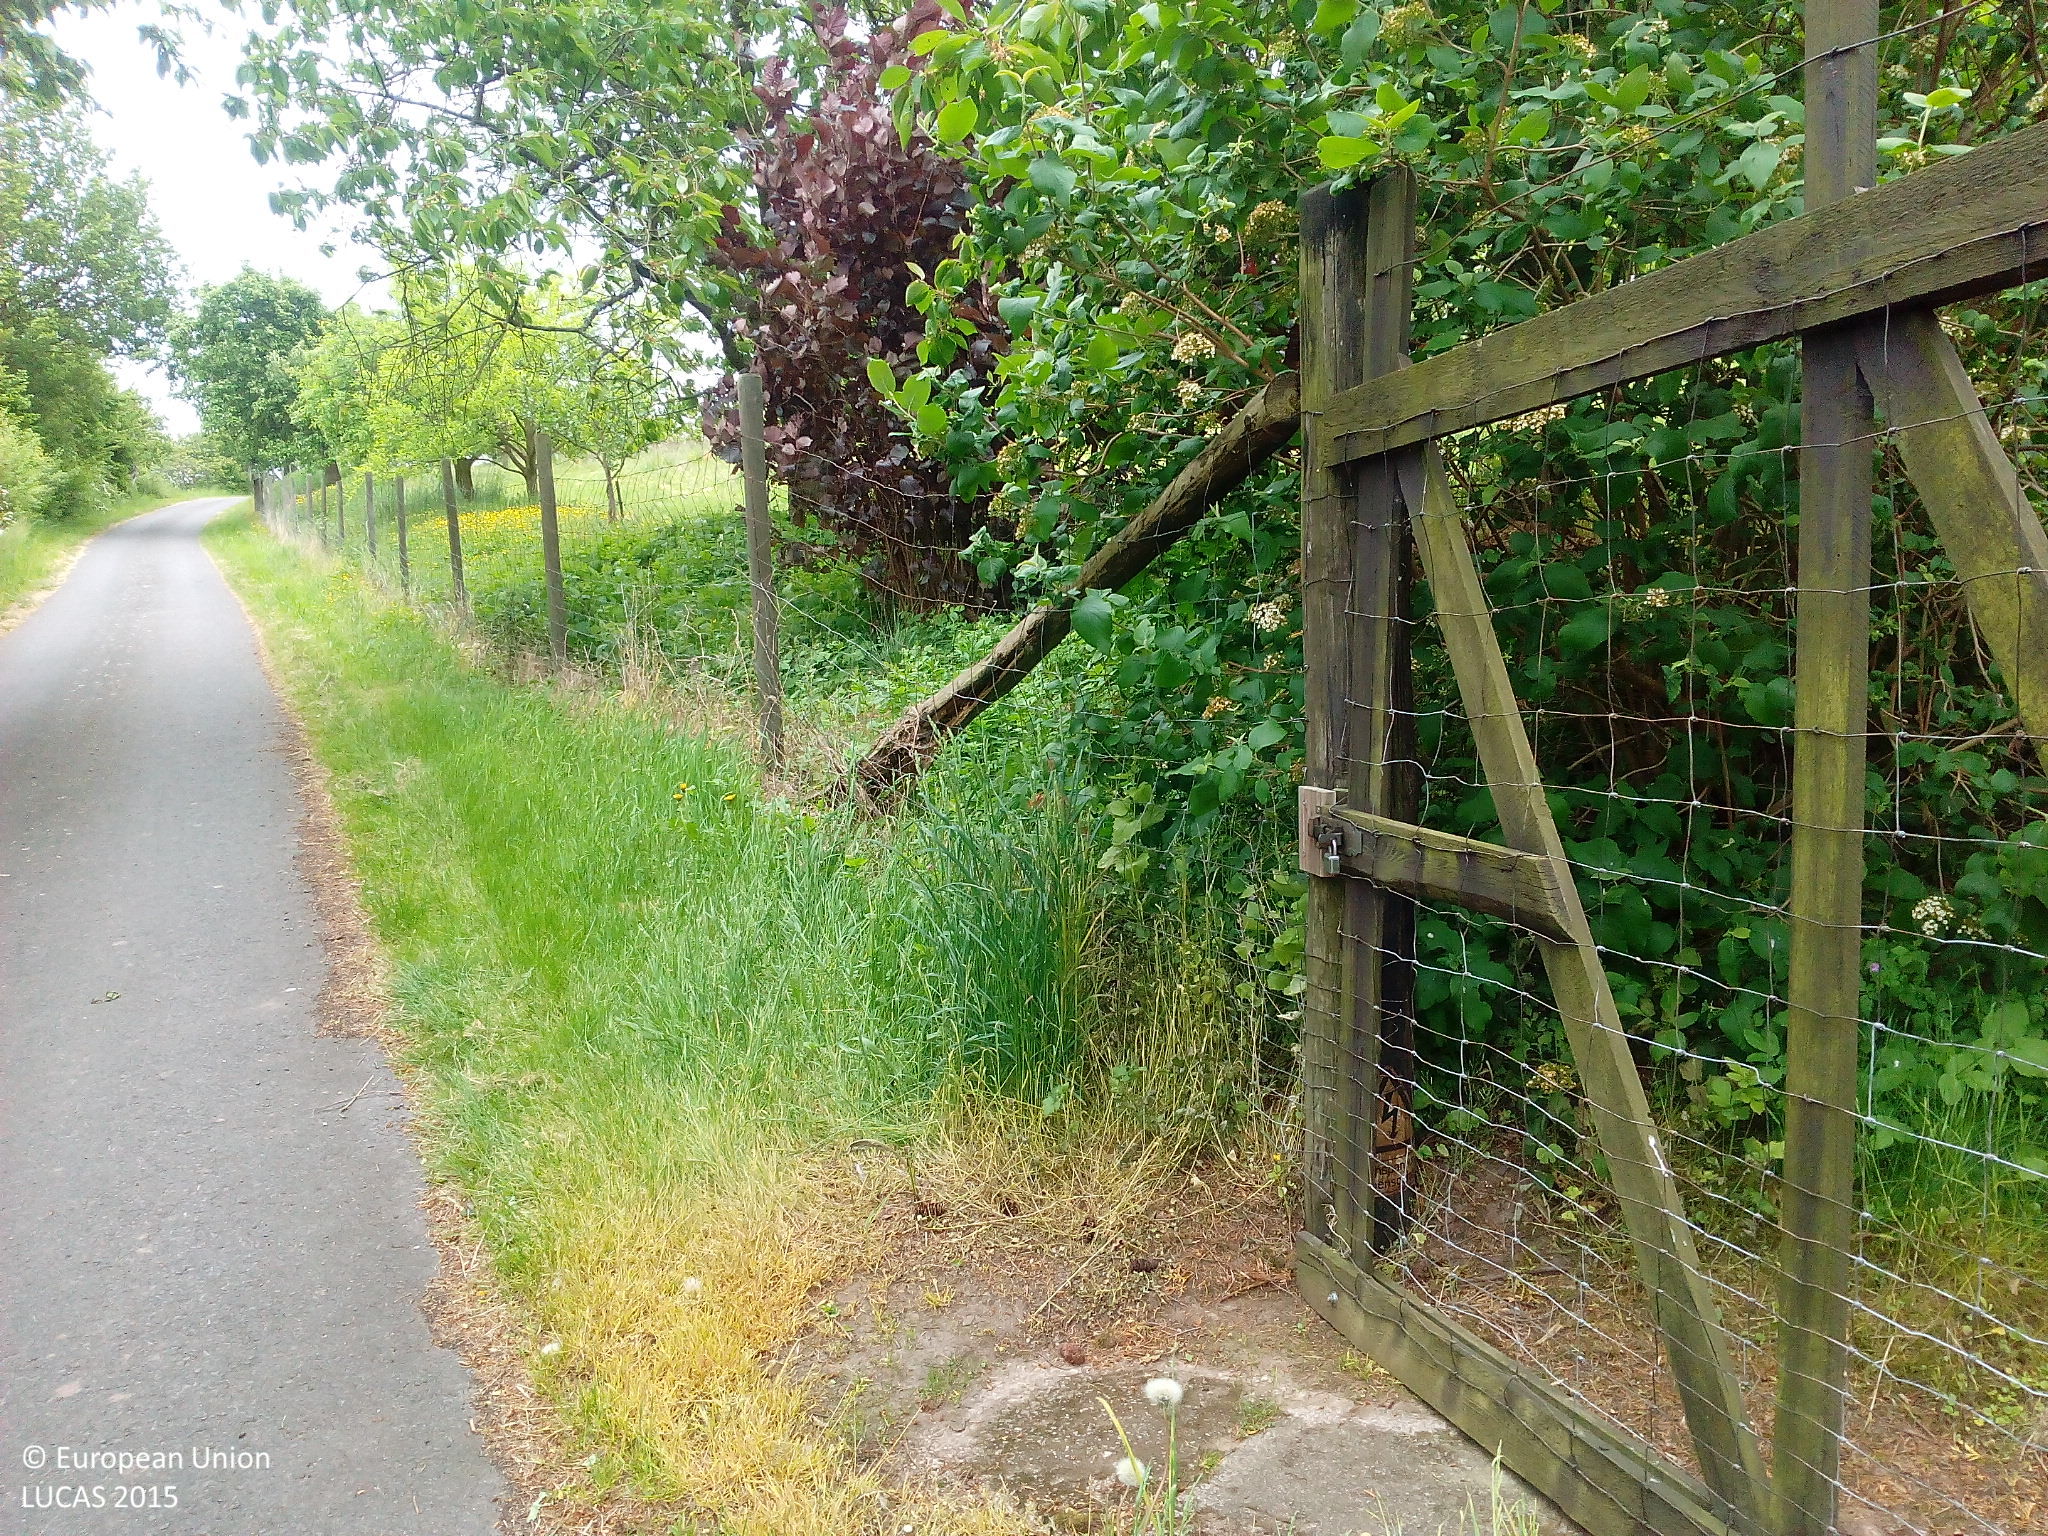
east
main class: Cropland
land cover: Cherry fruit
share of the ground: 10 - 25 %
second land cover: Grassland without tree/shrub cover
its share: > 75 %
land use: Agriculture (excluding fallow land and kitchen gardens)
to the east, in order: Cherry fruit; Grassland without tree/shrub cover; Fences; Grass margins; Paved roads, cycling and walking lanes; Grassland without tree/shrub cover; Paved roads, cycling and walking lanes; Managed hedges; Fences; Grassland without tree/shrub cover; Fences; Grassland without tree/shrub cover; Fences; Grassland without tree/shrub cover; Cherry fruit; Grassland without tree/shrub cover; Paved roads, cycling and walking lanes; Grass margins; Fences; Grassland without tree/shrub cover; Cherry fruit; Fences; Grass margins; Tracks; Grass margins; Common wheat
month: May
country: DE
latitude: 51.2988
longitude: 9.8423
